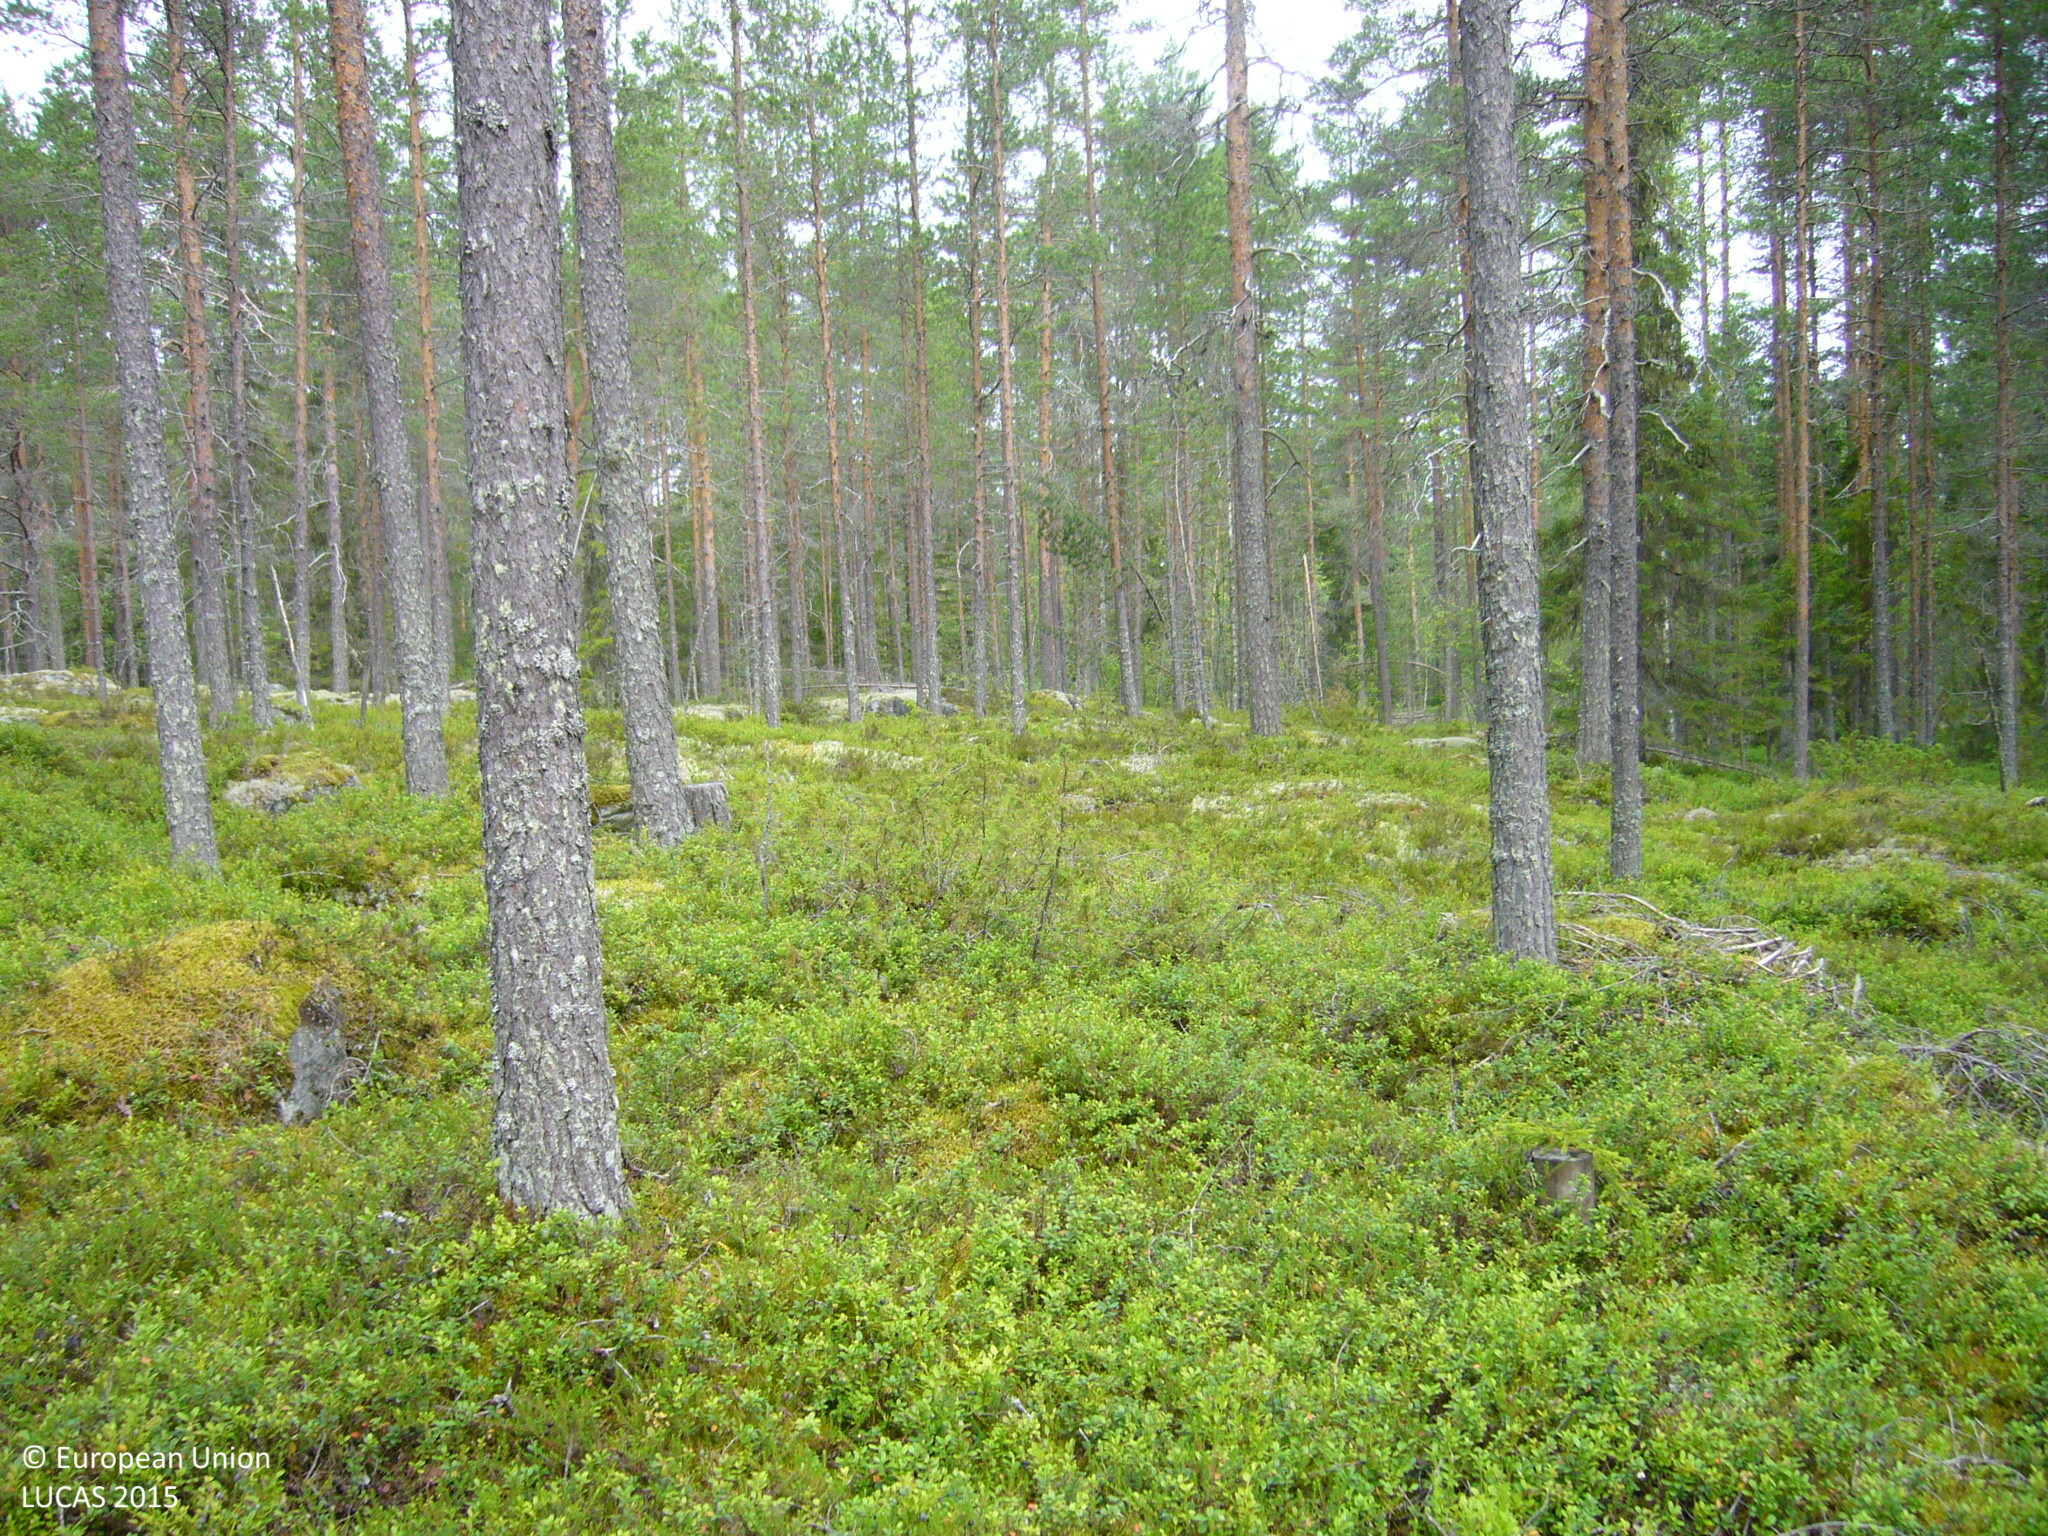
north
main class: Woodland
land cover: Pine dominated coniferous woodland
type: boreal forest
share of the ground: 50 - 75 %
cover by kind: coniferous forest trees 60 %, shrubs 30 %, lichens and mosses 10 %
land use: Forestry
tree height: > 5 m
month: July
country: FI
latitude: 63.8982
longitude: 25.7692
